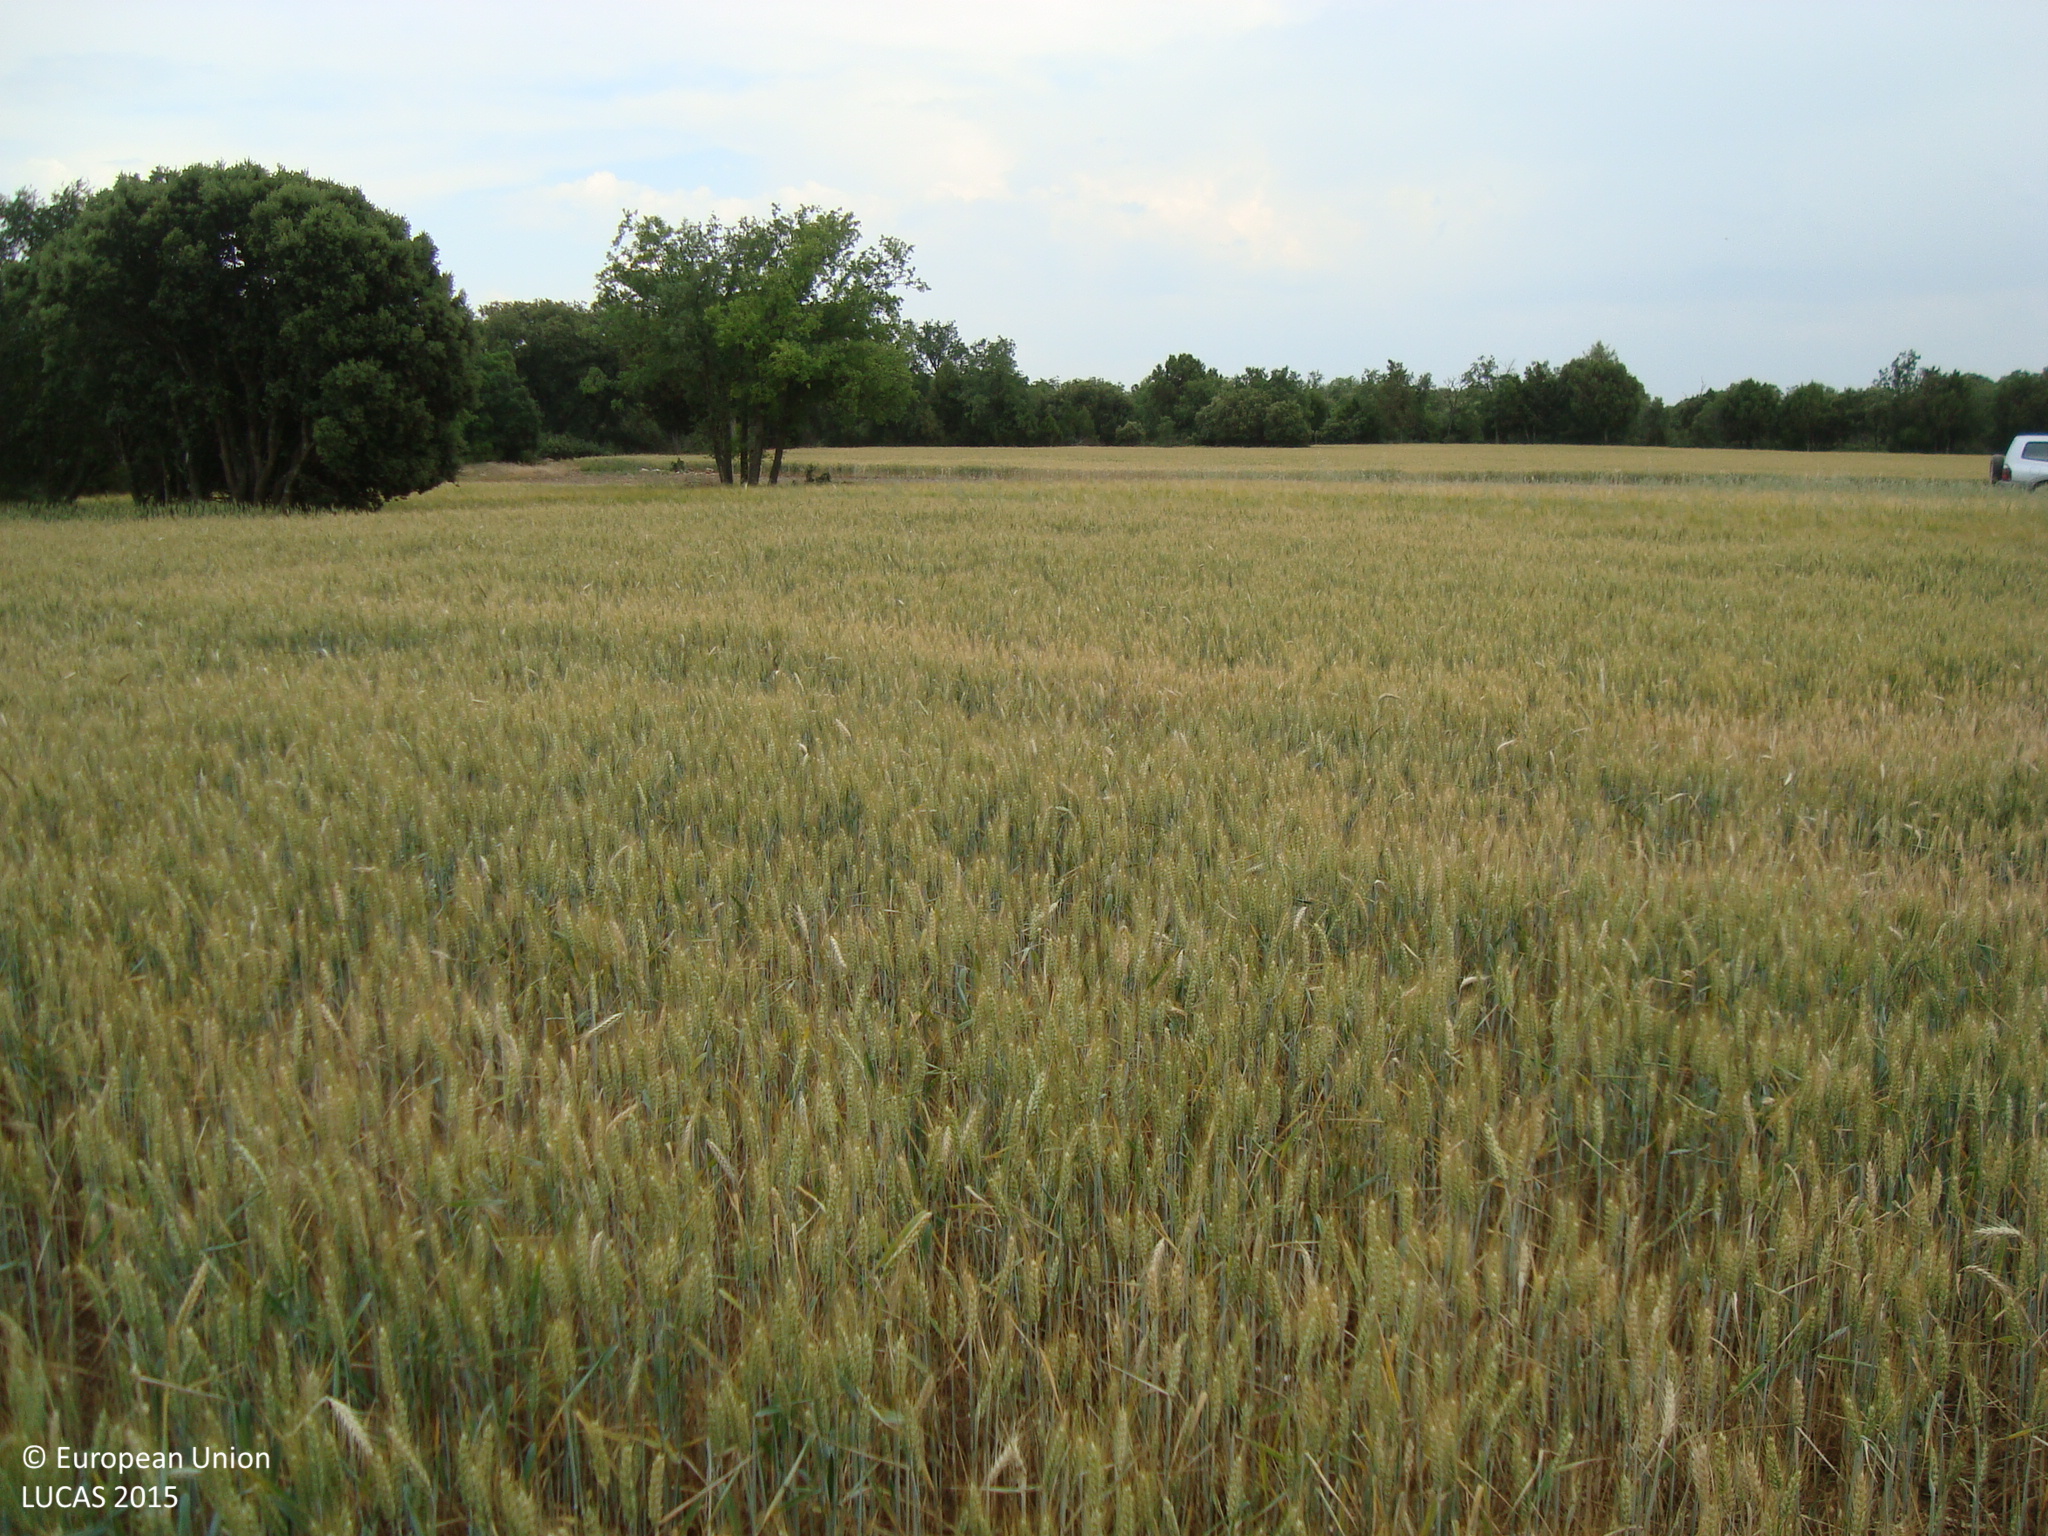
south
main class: Cropland
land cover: Common wheat
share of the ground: > 75 %
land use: Agriculture (excluding fallow land and kitchen gardens)
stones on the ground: < 10 %
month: June
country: ES
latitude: 41.9381
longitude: -3.6971
